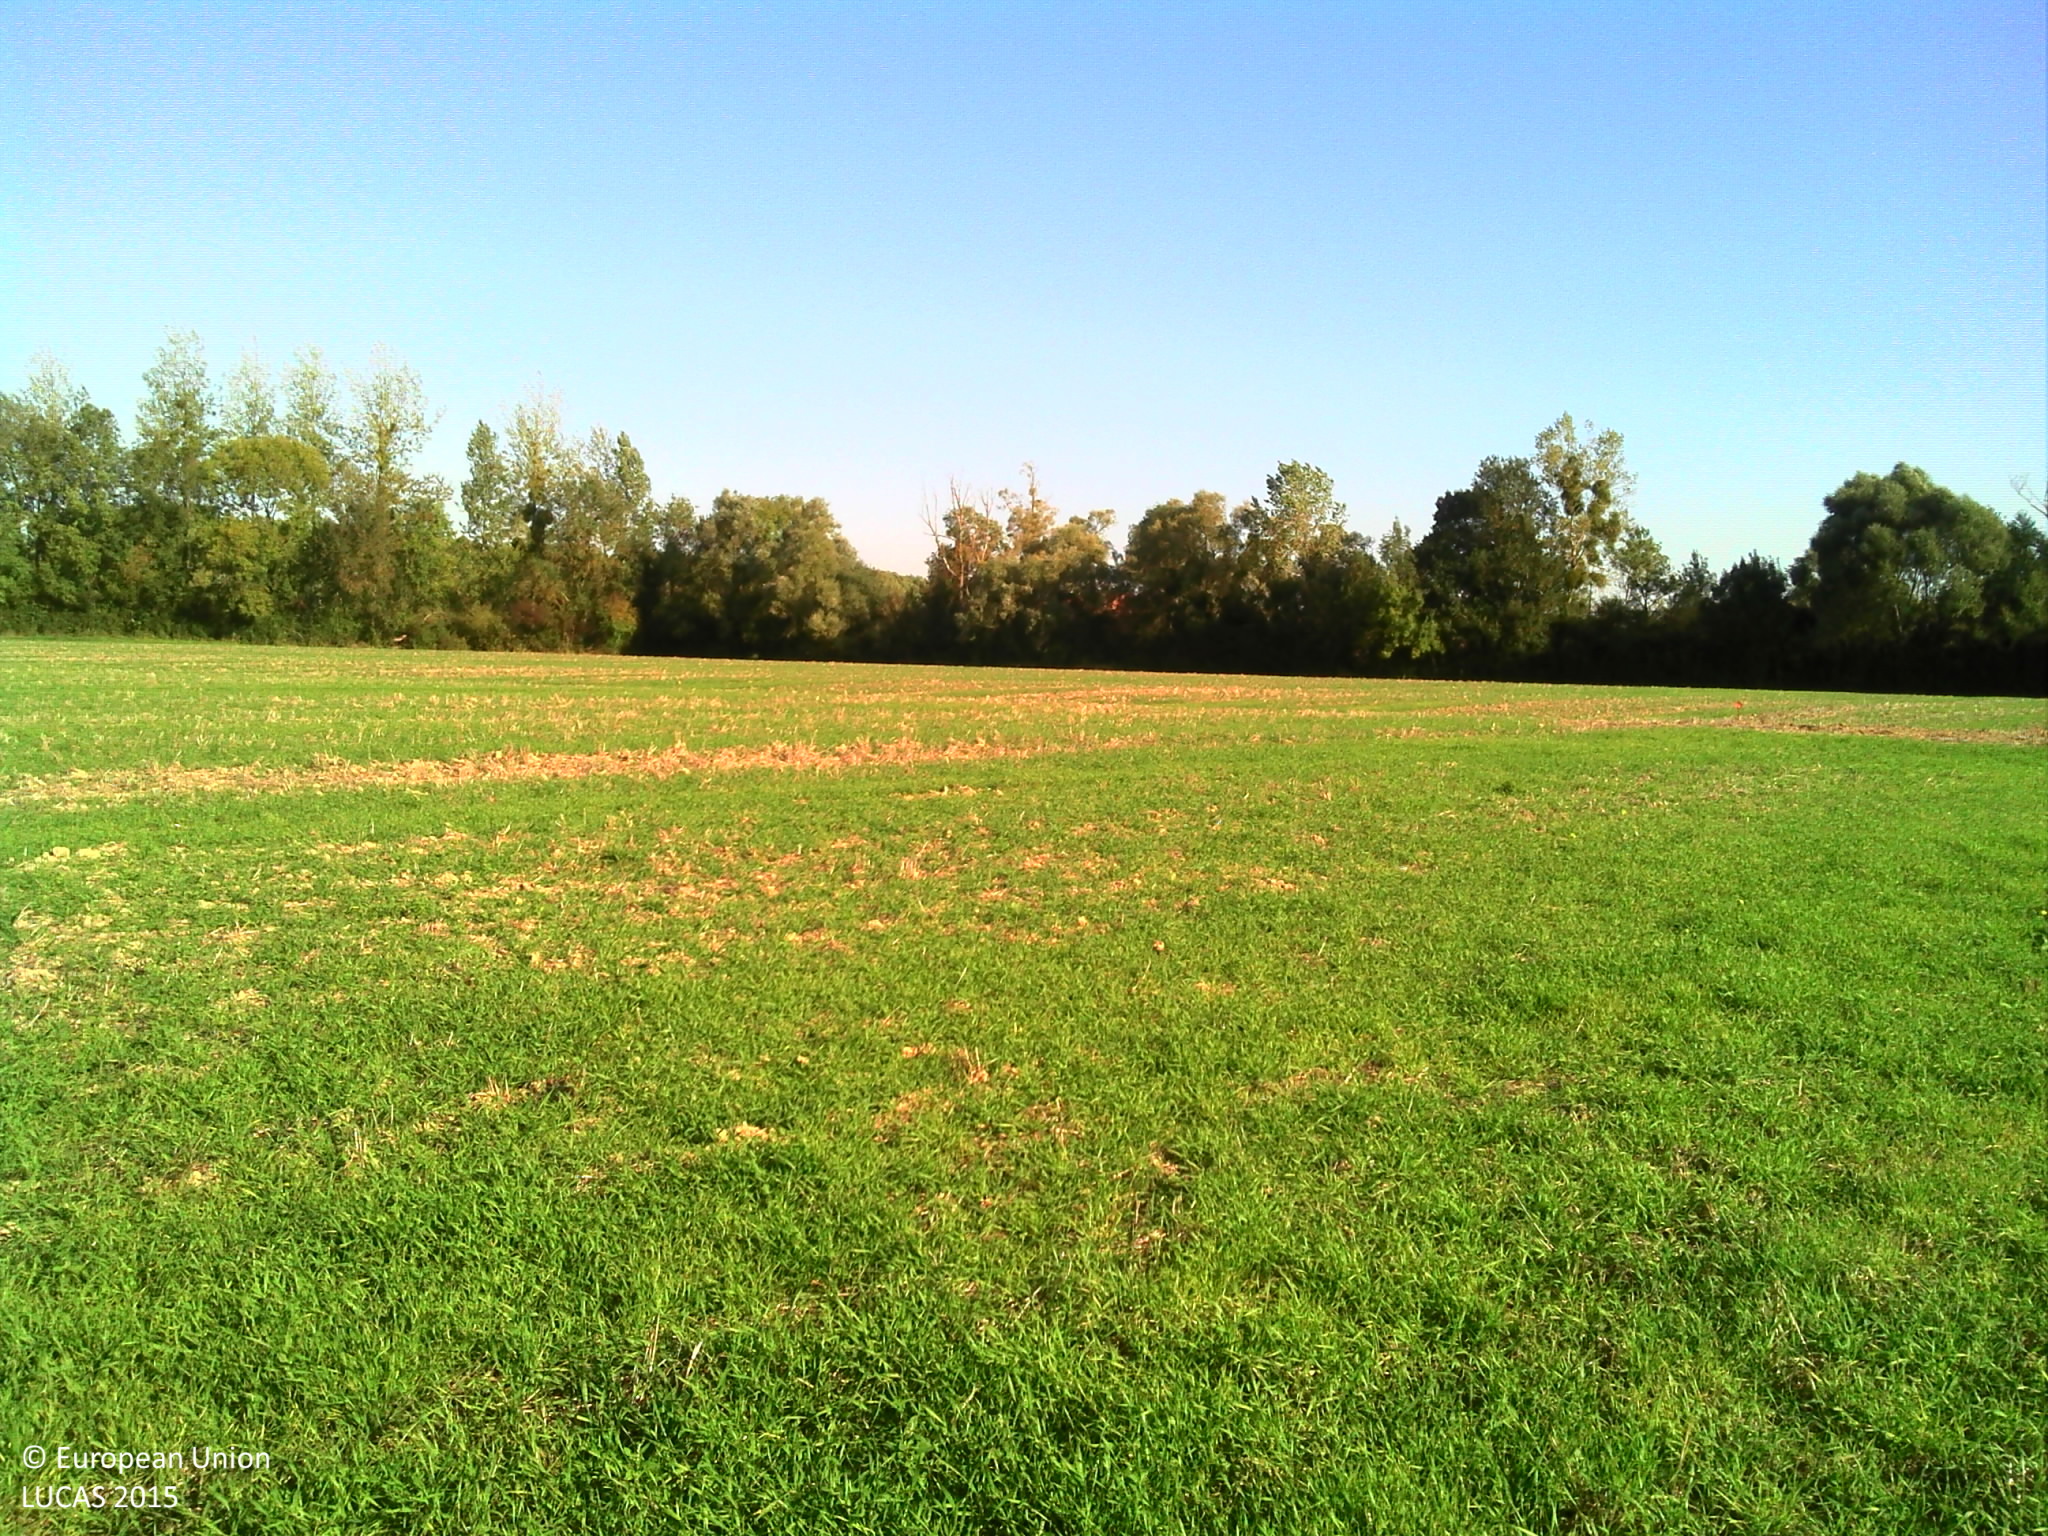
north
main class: Cropland
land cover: Common wheat
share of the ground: < 10 %
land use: Agriculture (excluding fallow land and kitchen gardens)
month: September
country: FR
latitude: 48.4579
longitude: 3.3811
